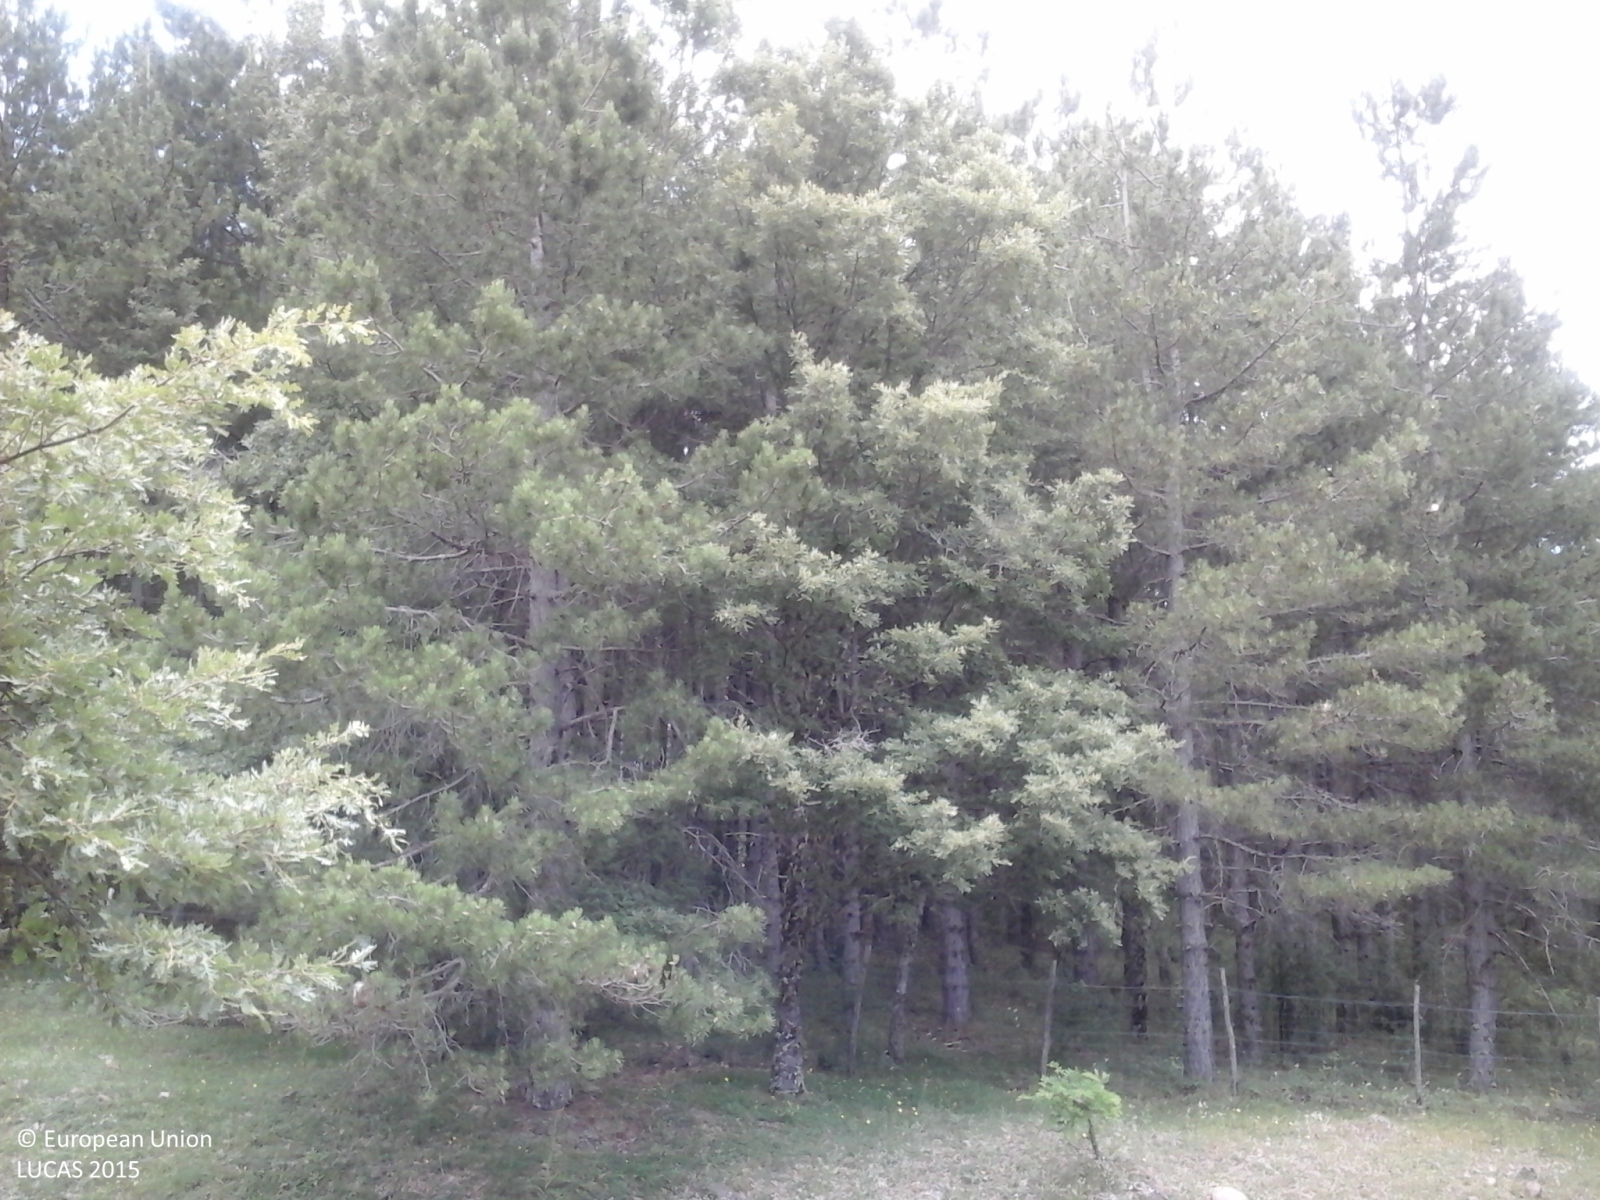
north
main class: Woodland
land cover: Broadleaved woodland
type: thermophilous deciduous forest
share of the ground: > 75 %
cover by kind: broadleaved forest trees 75 %, shrubs 15 %, herbaceous plants 10 %
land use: Amenities, museums, leisure
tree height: > 5 m
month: July
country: IT
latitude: 37.9329
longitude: 14.8481
